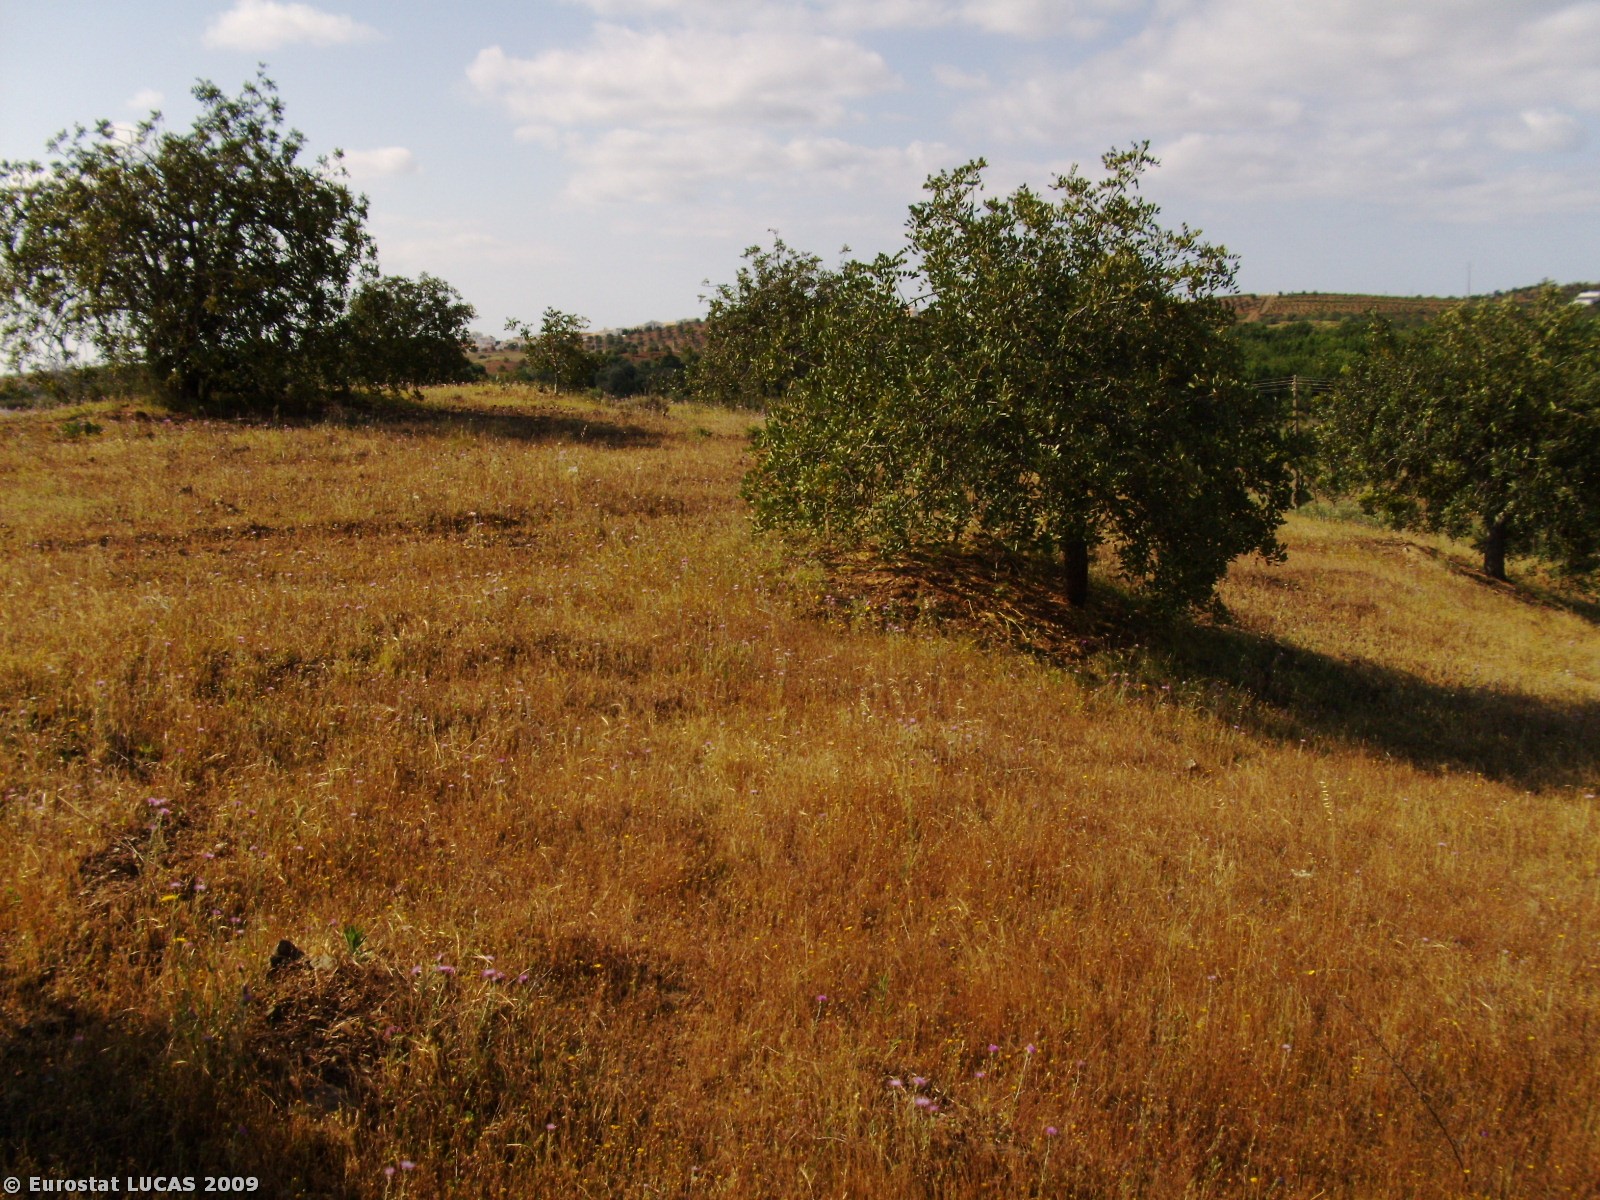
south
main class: Cropland
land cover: Permanent industrial crops
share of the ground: 10 - 25 %
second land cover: Spontaneously vegetated surfaces
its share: > 75 %
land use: Agriculture (excluding fallow land and kitchen gardens)
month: April
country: PT
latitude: 37.2240
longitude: -7.4833
